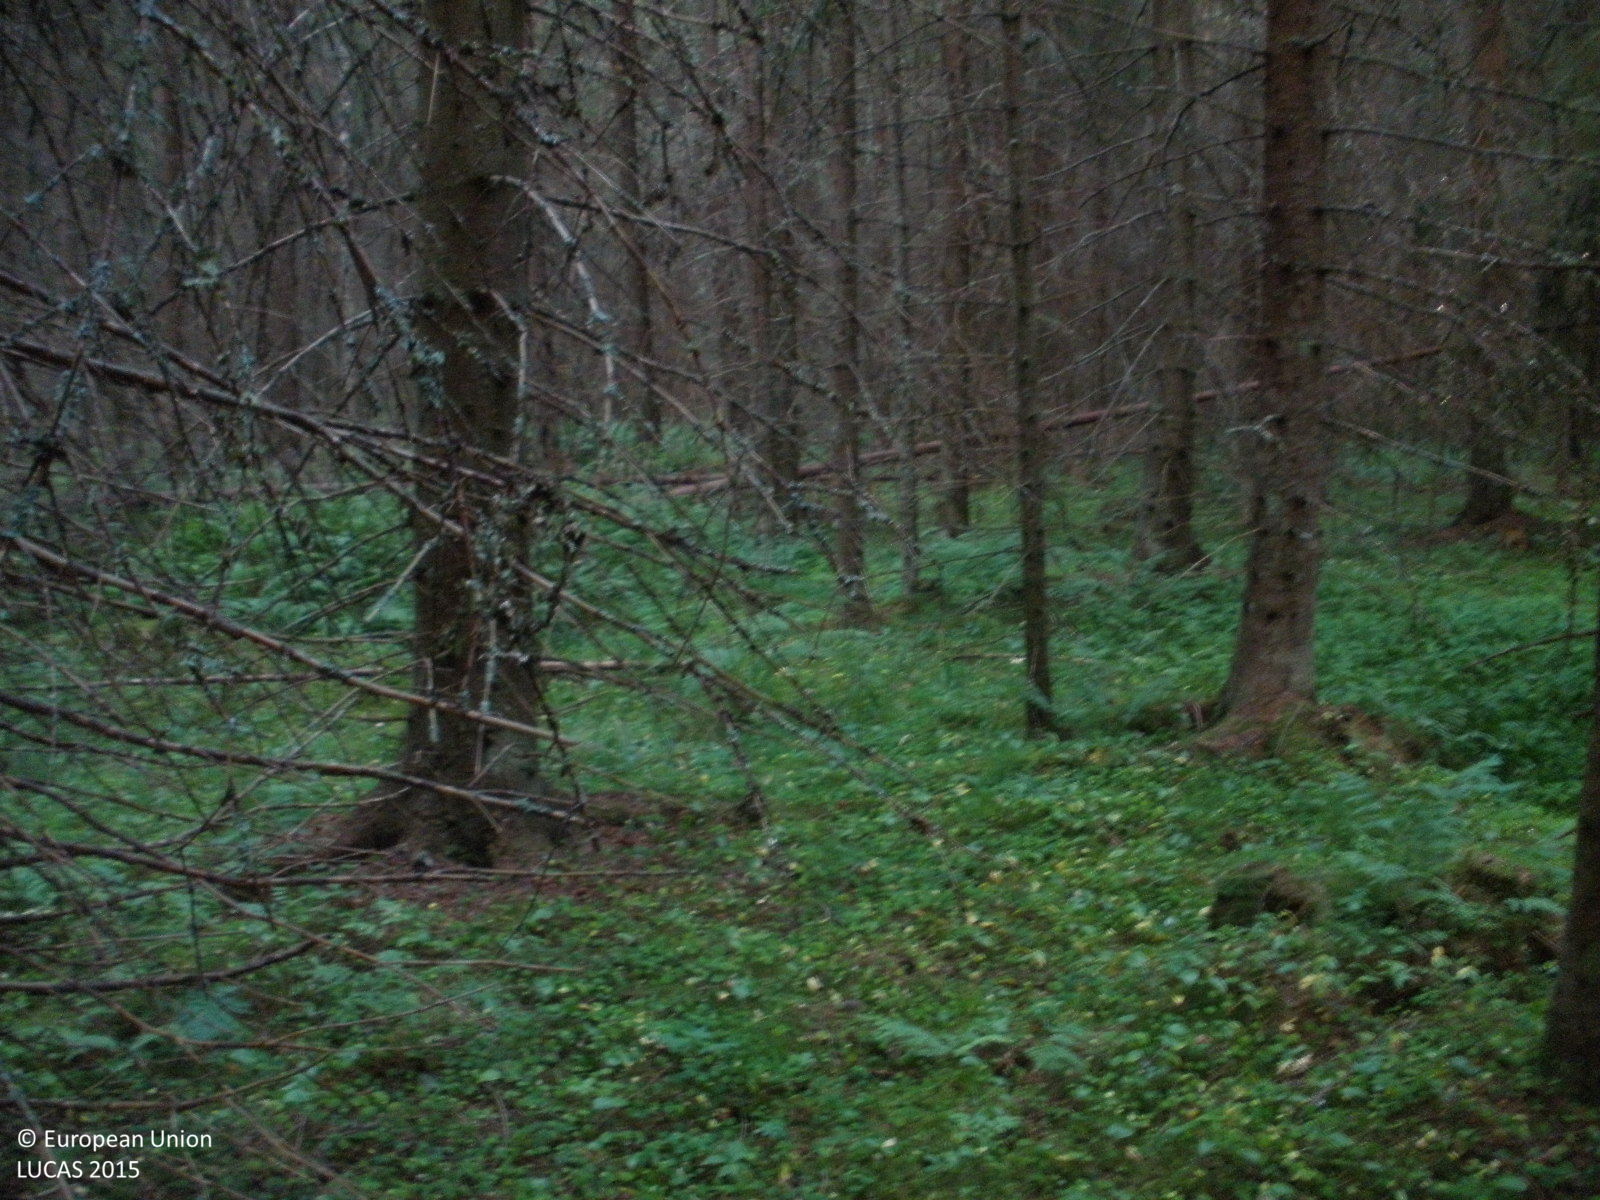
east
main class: Woodland
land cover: Spruce dominated coniferous woodland
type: boreal forest
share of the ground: > 75 %
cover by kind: coniferous forest trees 90 %, herbaceous plants 5 %, lichens and mosses 5 %
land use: Forestry
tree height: > 5 m
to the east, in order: Spruce dominated coniferous woodland; Rivers and streams; Spruce dominated coniferous woodland; Paved roads, cycling and walking lanes; Electric lines; Spontaneously vegetated surfaces; Ditches and canals; Spruce dominated mixed woodland
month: August
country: FI
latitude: 60.9889
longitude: 24.6531
